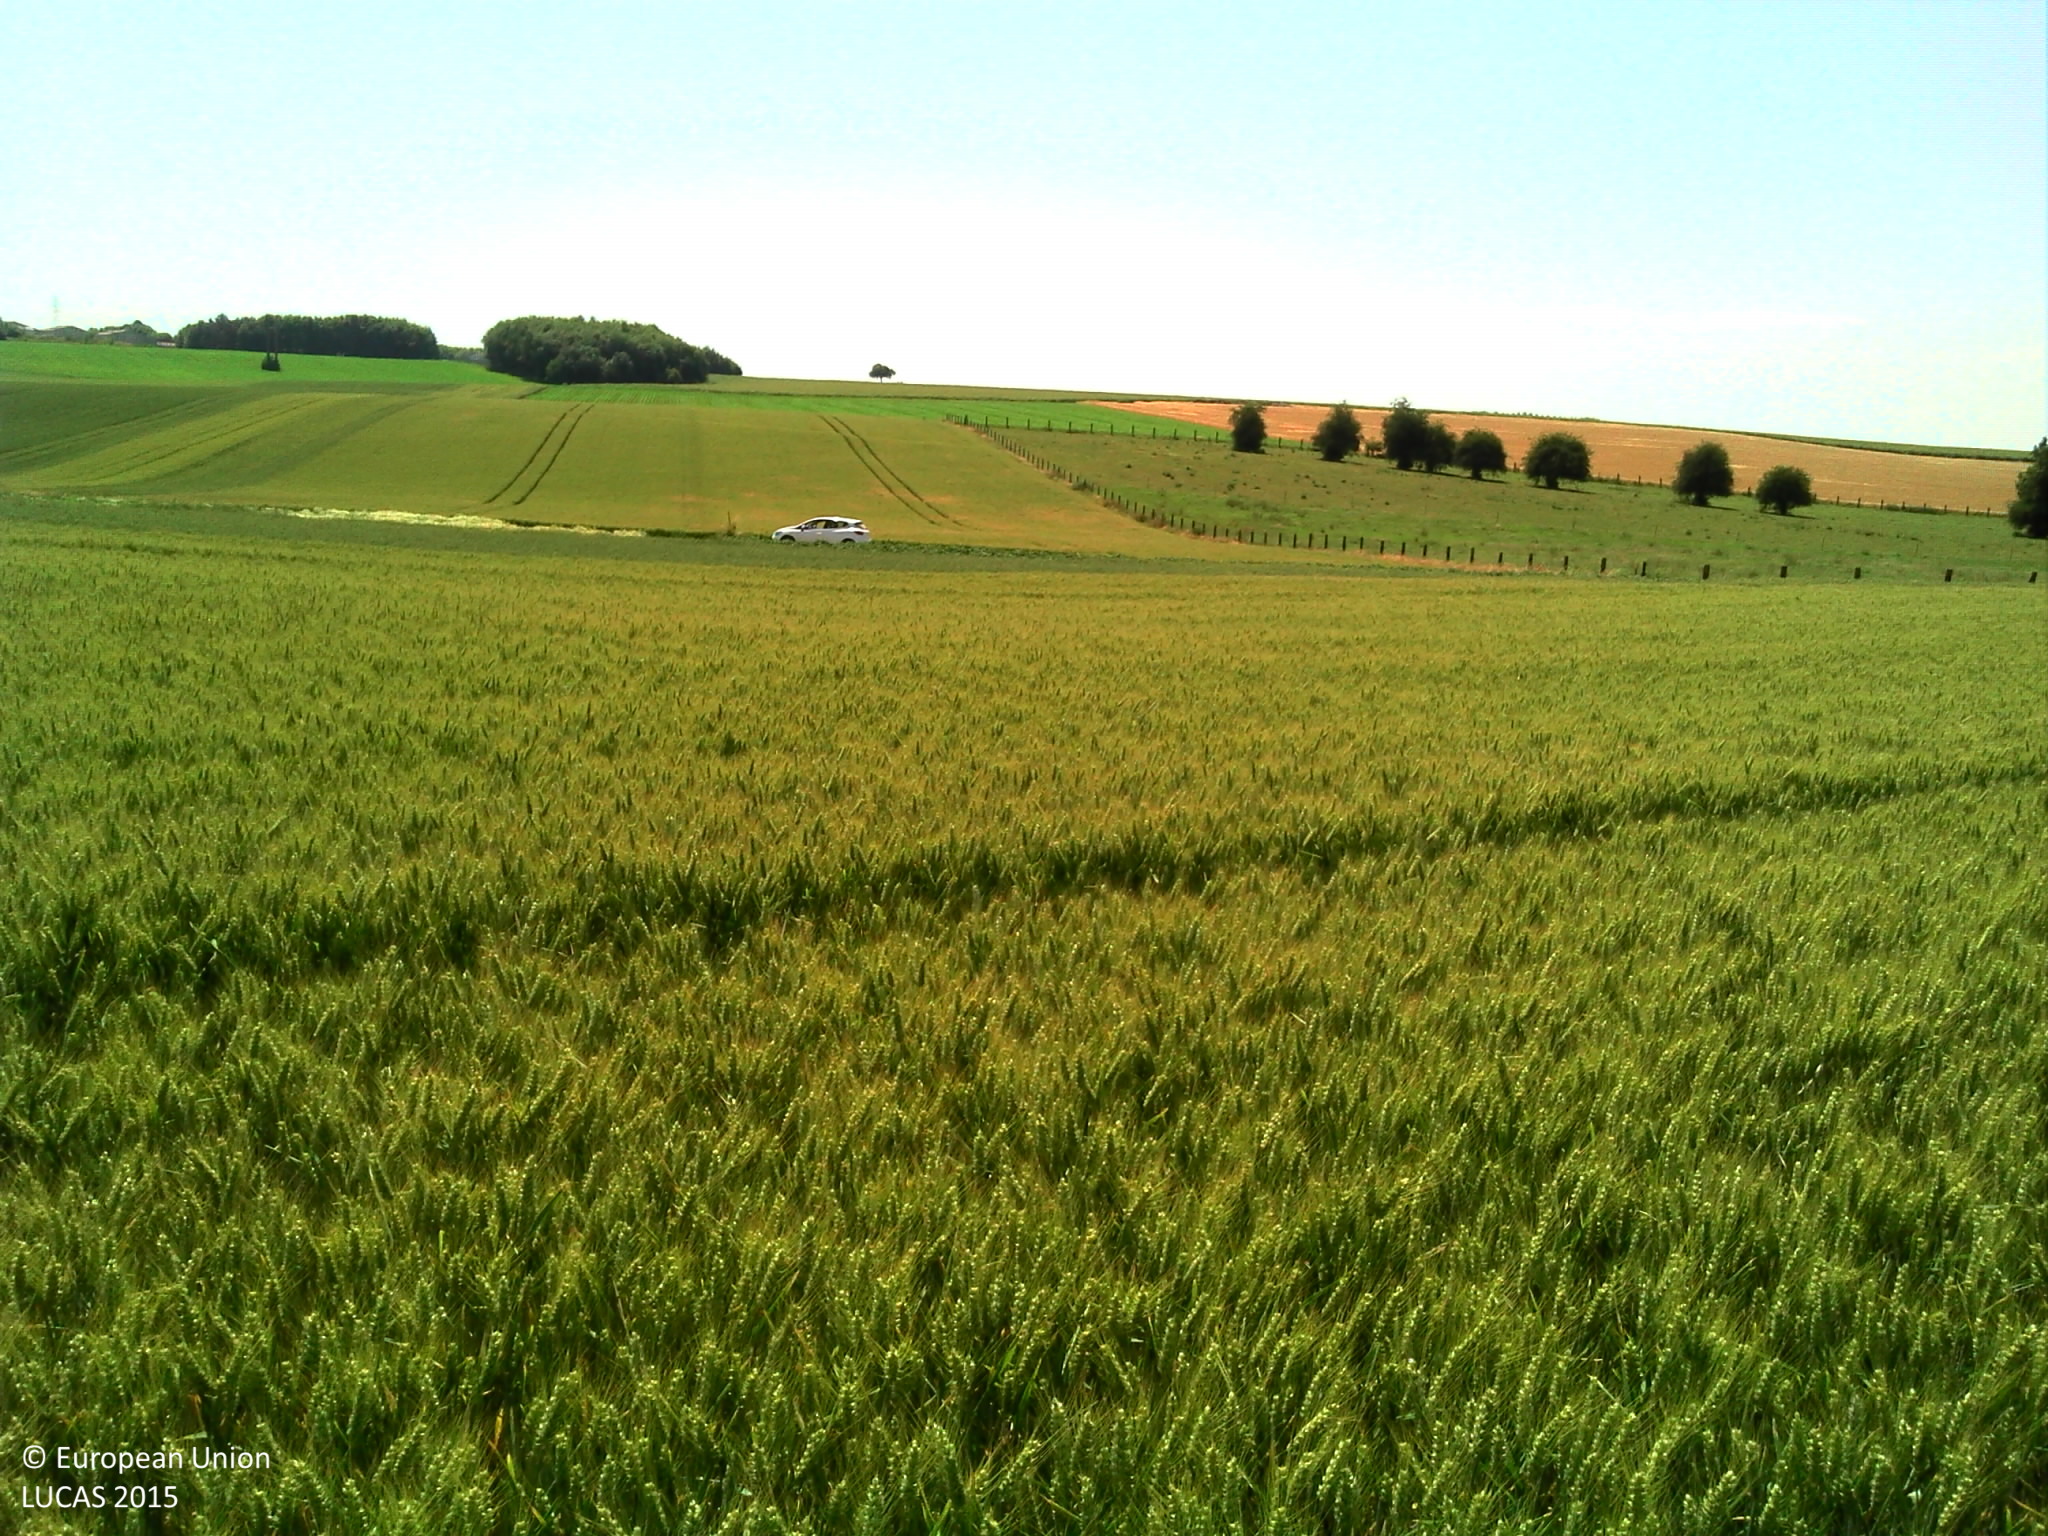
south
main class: Cropland
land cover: Common wheat
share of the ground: > 75 %
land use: Agriculture (excluding fallow land and kitchen gardens)
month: July
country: FR
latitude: 50.2807
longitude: 2.5078
